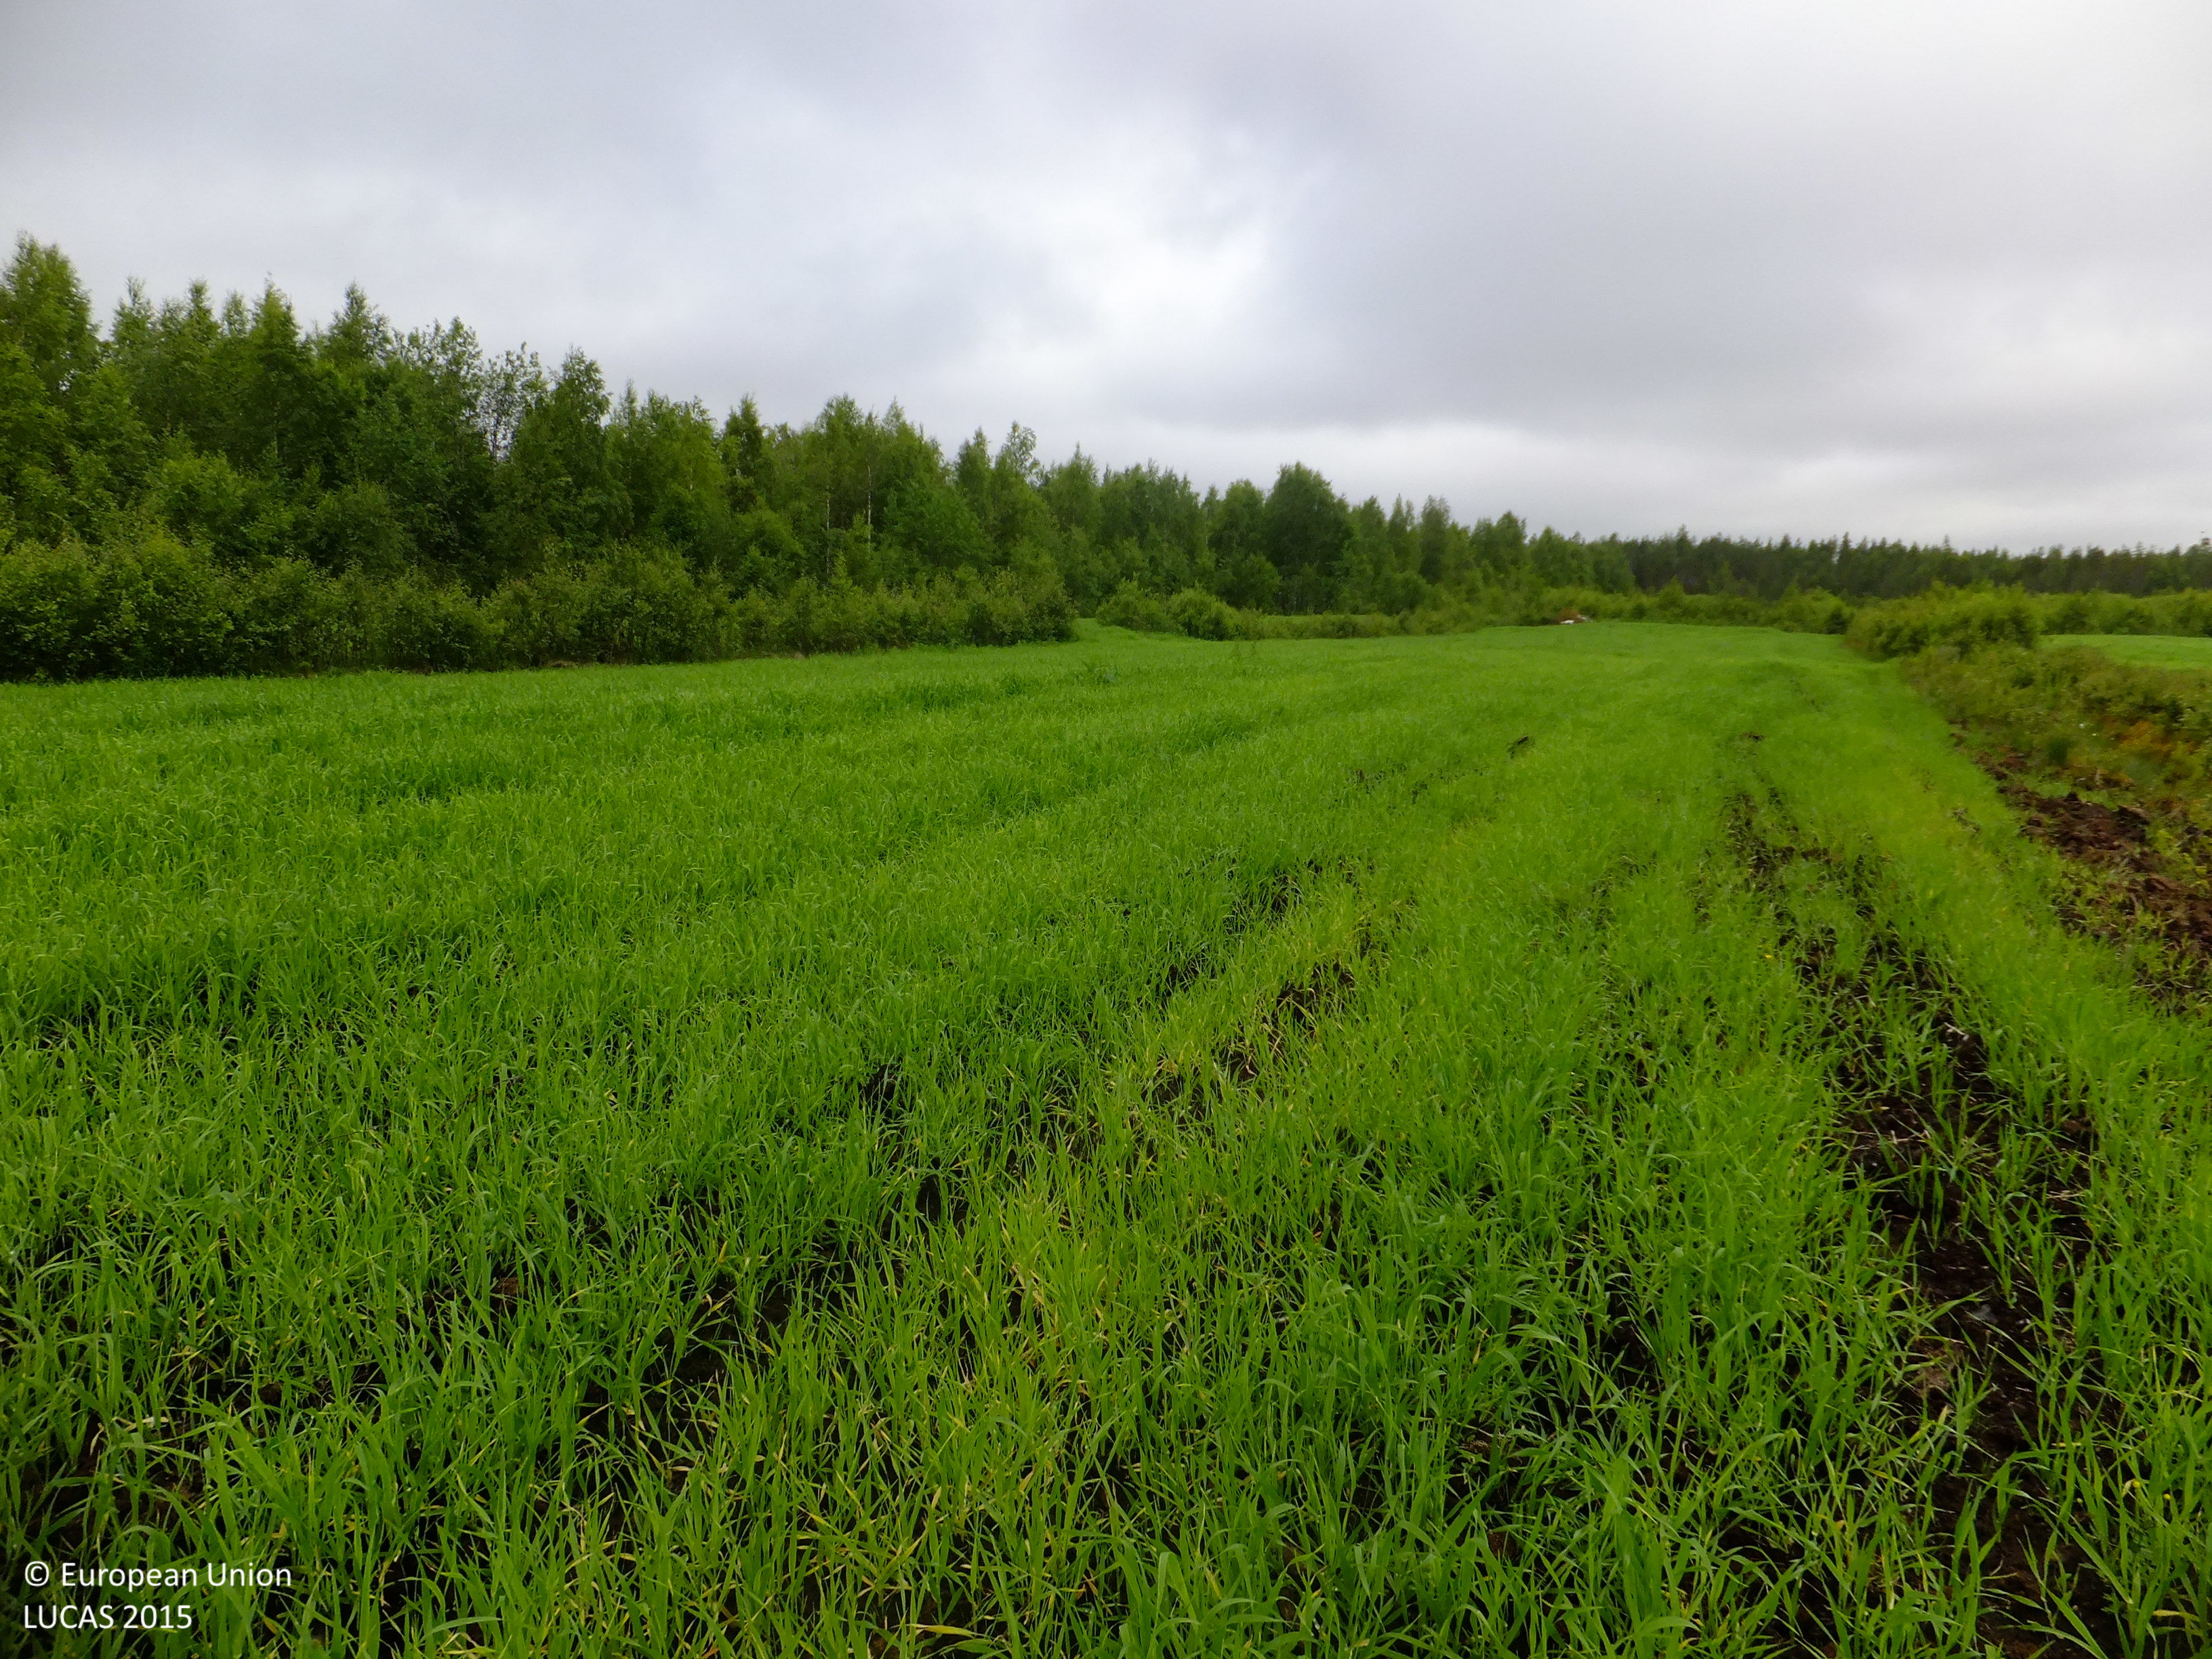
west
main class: Cropland
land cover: Barley
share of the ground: 50 - 75 %
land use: Agriculture (excluding fallow land and kitchen gardens)
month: July
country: FI
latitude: 63.1577
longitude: 24.6773
